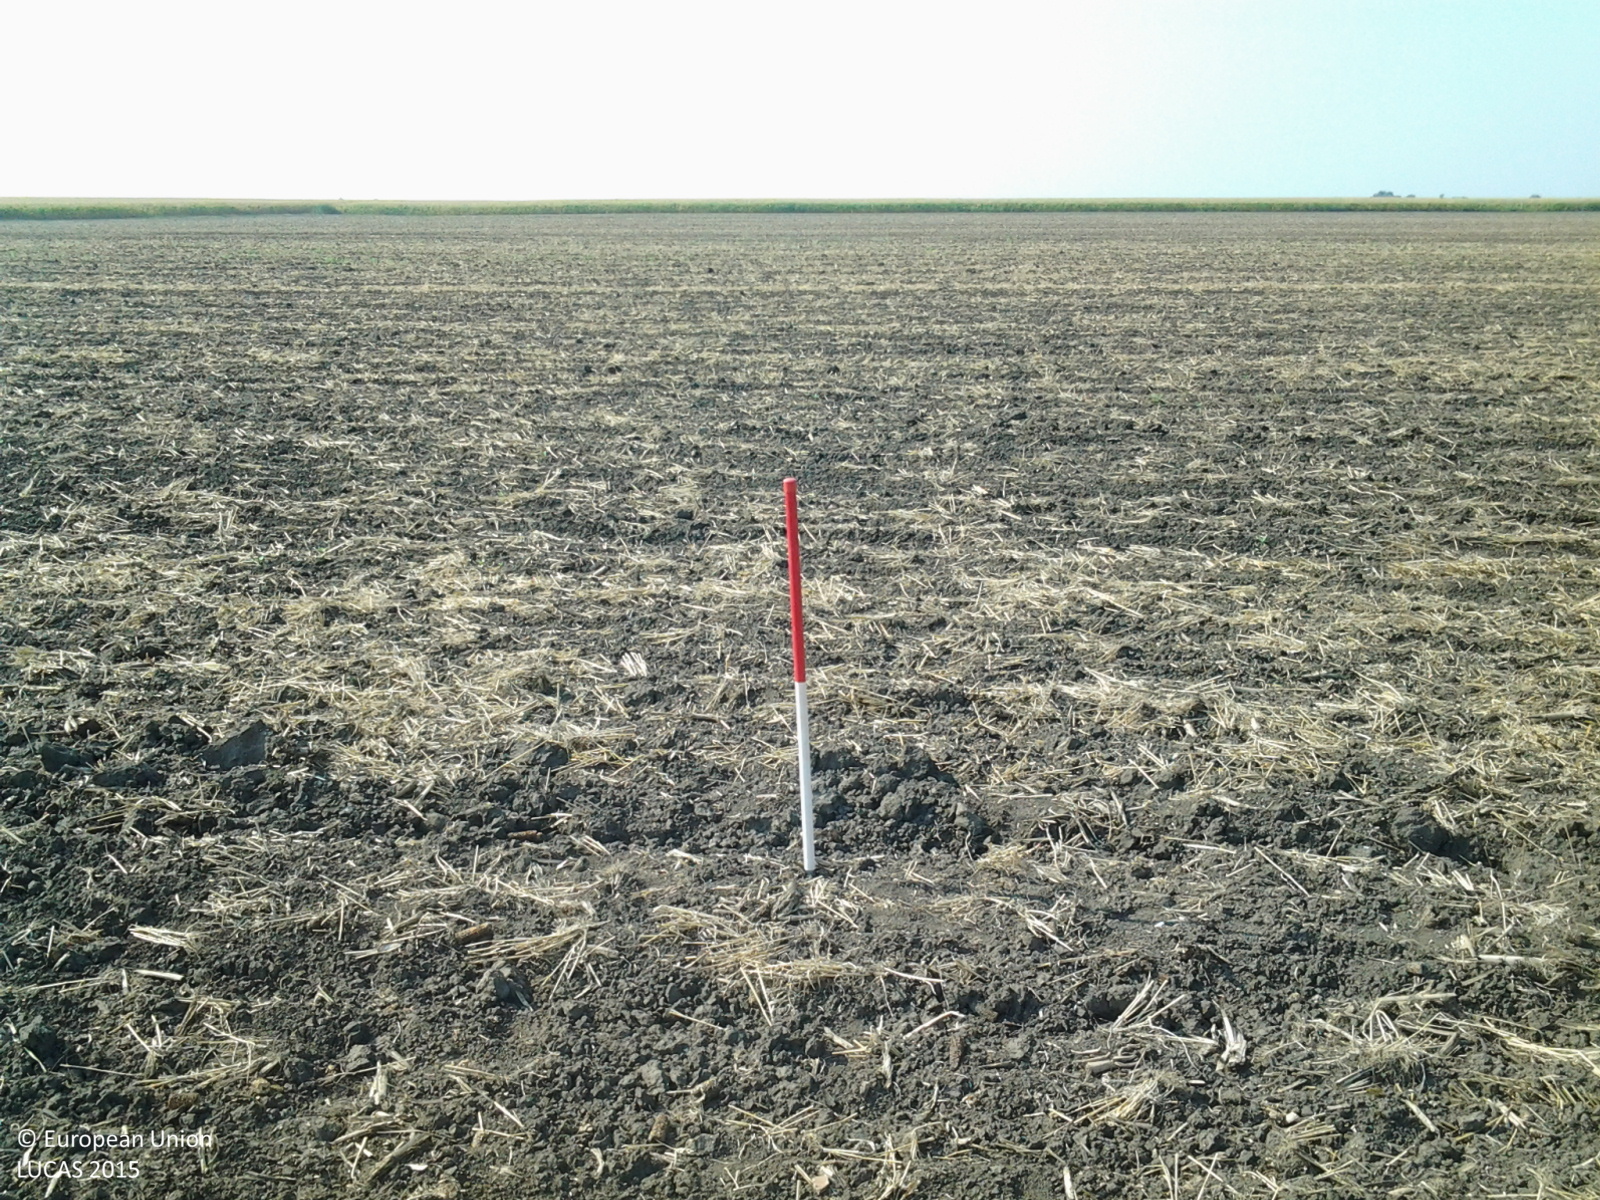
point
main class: Cropland
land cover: Common wheat
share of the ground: 10 - 25 %
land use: Agriculture (excluding fallow land and kitchen gardens)
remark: Harvested field
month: August
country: HU
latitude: 46.3131
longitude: 21.1354
